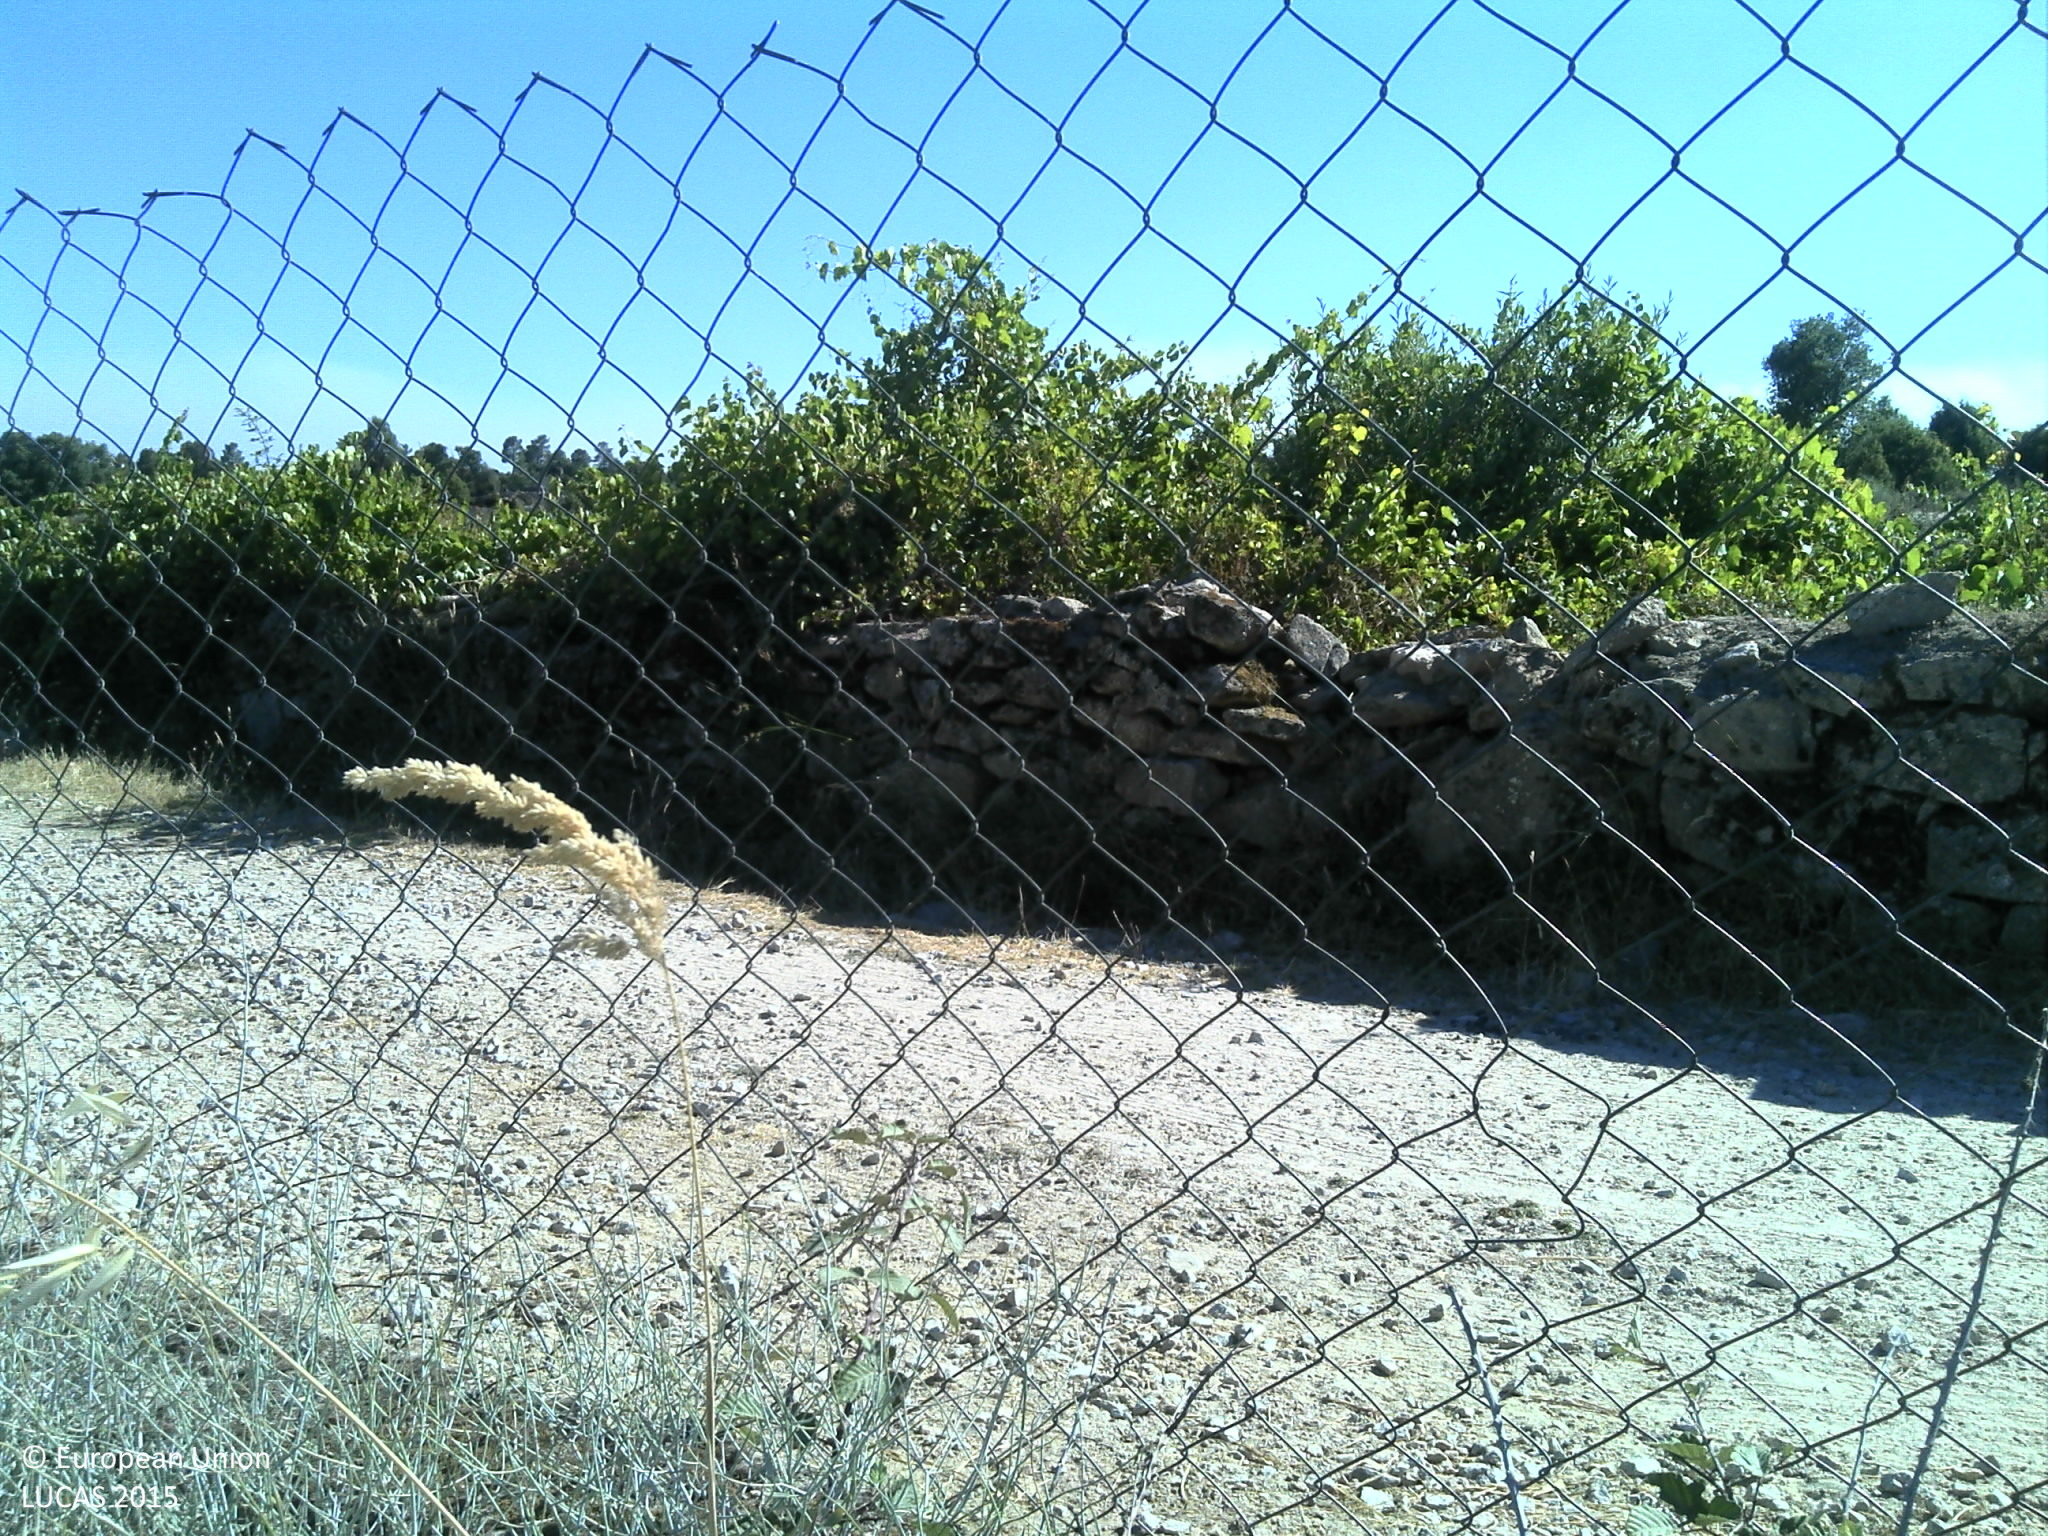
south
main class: Cropland
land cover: Other cereals
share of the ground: > 75 %
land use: Agriculture (excluding fallow land and kitchen gardens)
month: July
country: PT
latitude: 41.2517
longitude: -7.0462
